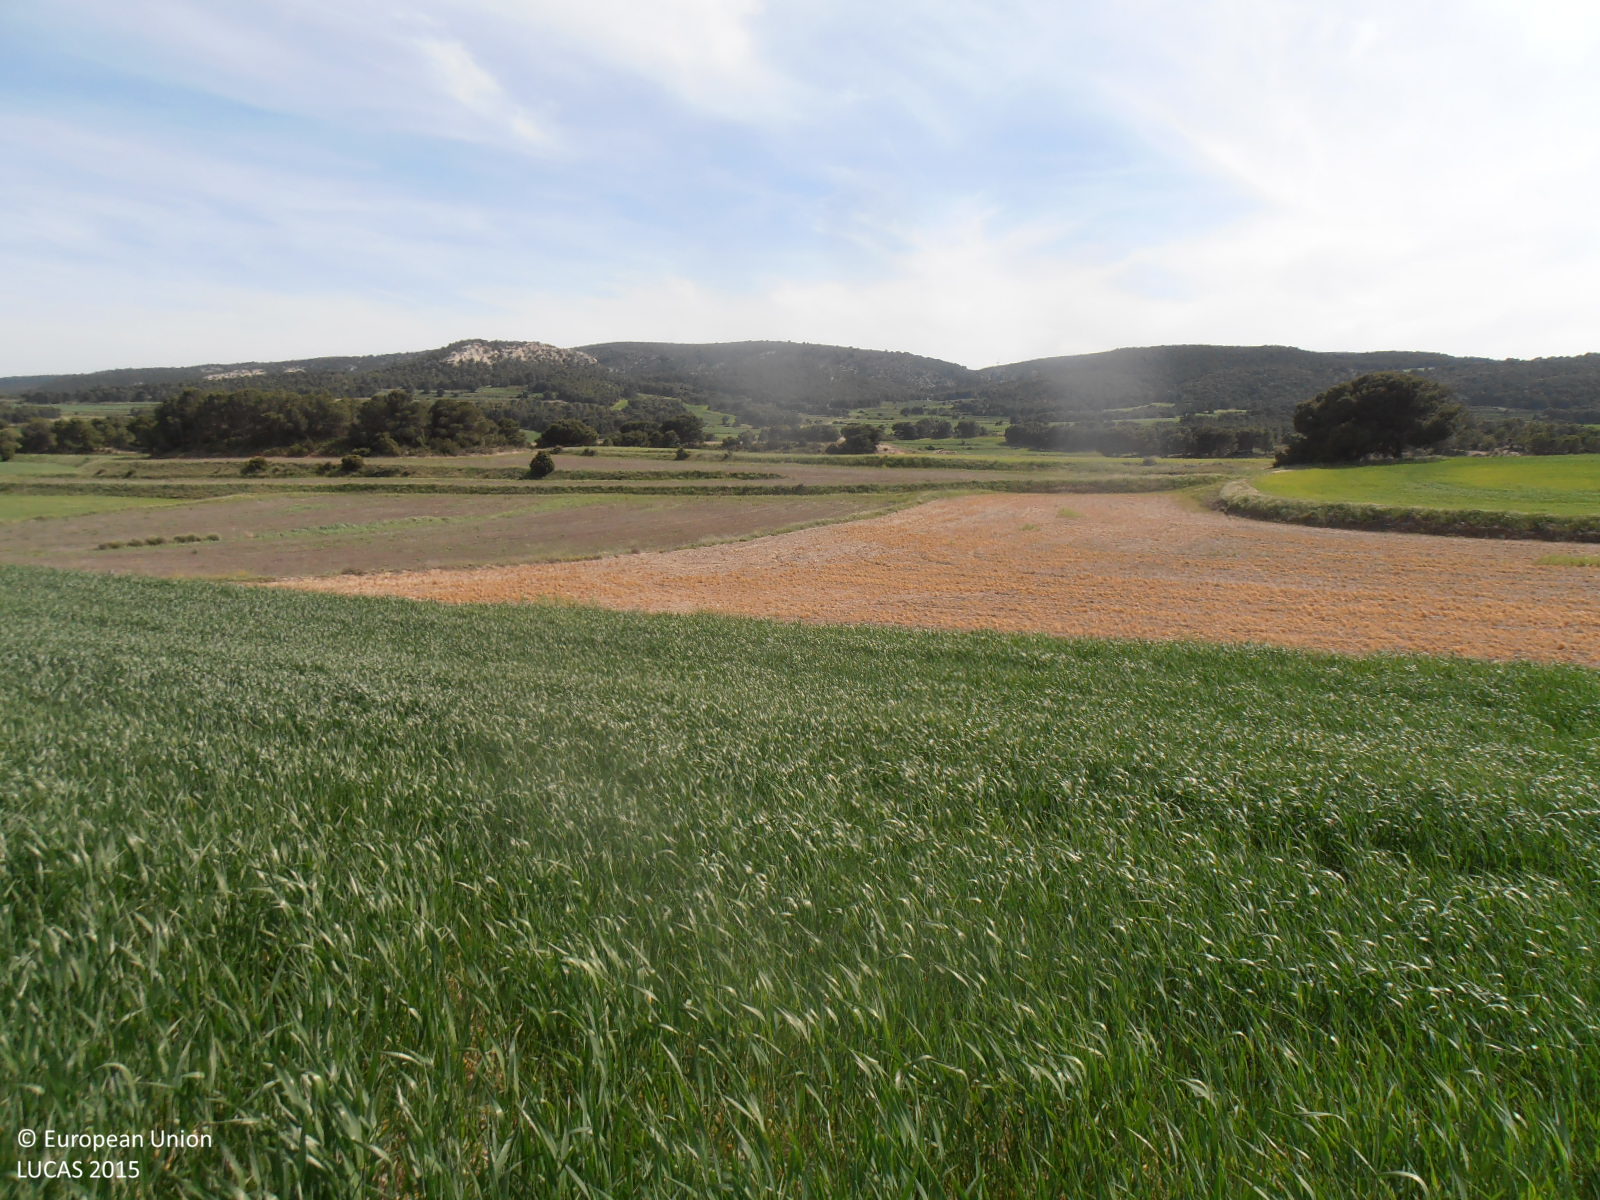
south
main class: Cropland
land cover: Durum wheat
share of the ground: > 75 %
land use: Agriculture (excluding fallow land and kitchen gardens)
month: April
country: ES
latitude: 41.3707
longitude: -0.9111
